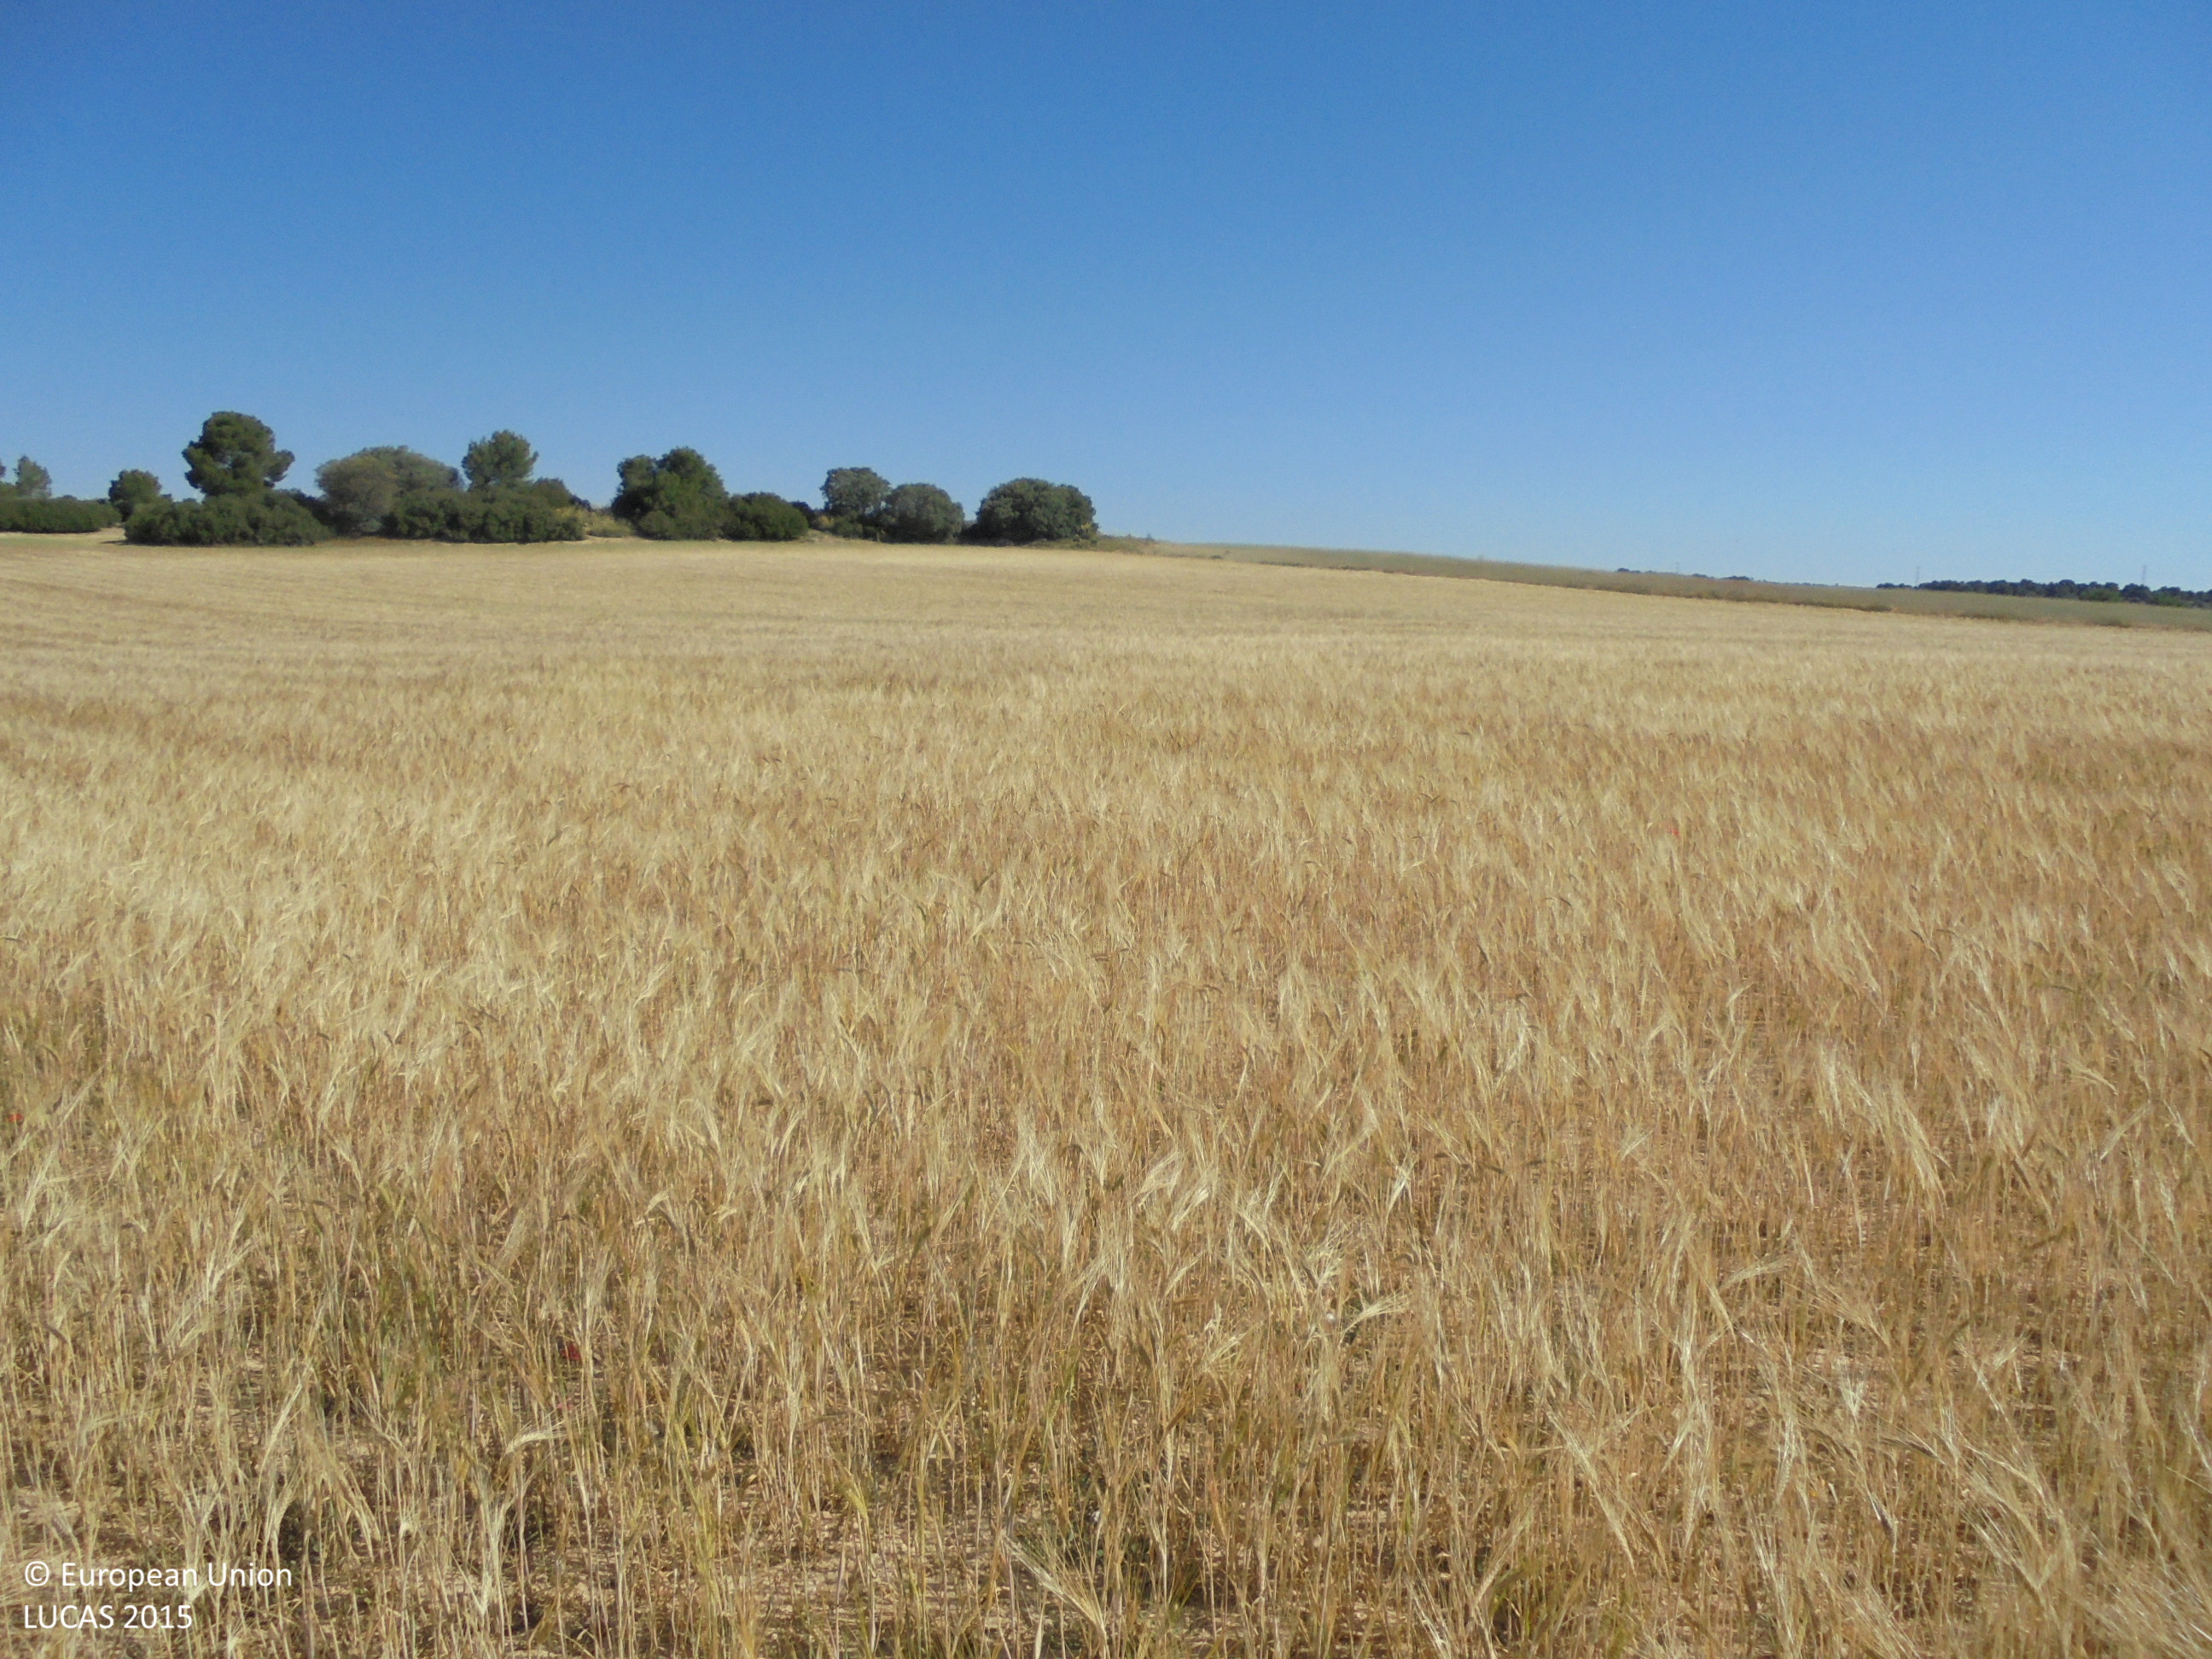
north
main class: Cropland
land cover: Barley
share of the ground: 50 - 75 %
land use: Agriculture (excluding fallow land and kitchen gardens)
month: June
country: ES
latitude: 38.7841
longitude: -1.6579
